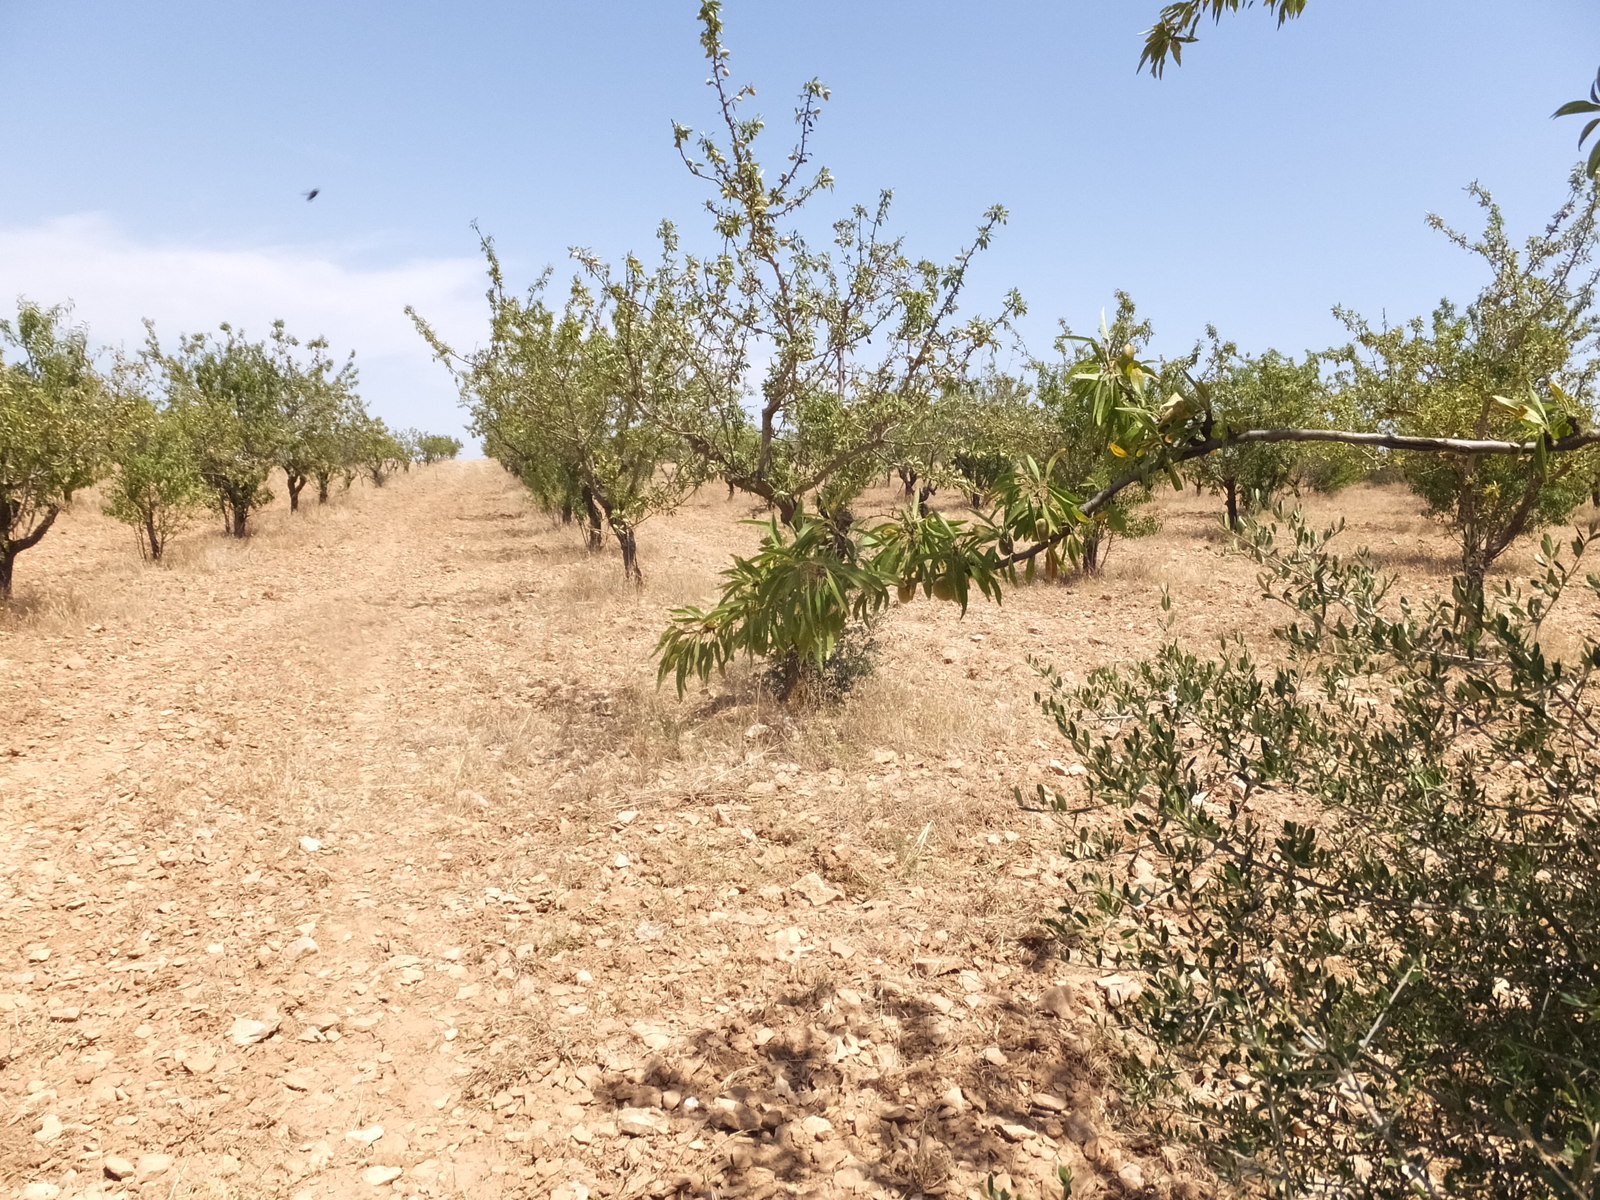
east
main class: Cropland
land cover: Nuts trees
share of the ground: 25 - 50 %
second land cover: Other bare soil
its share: > 75 %
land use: Agriculture (excluding fallow land and kitchen gardens)
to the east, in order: Nuts trees; Other bare soil
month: July
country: ES
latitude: 41.4382
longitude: 0.4497
